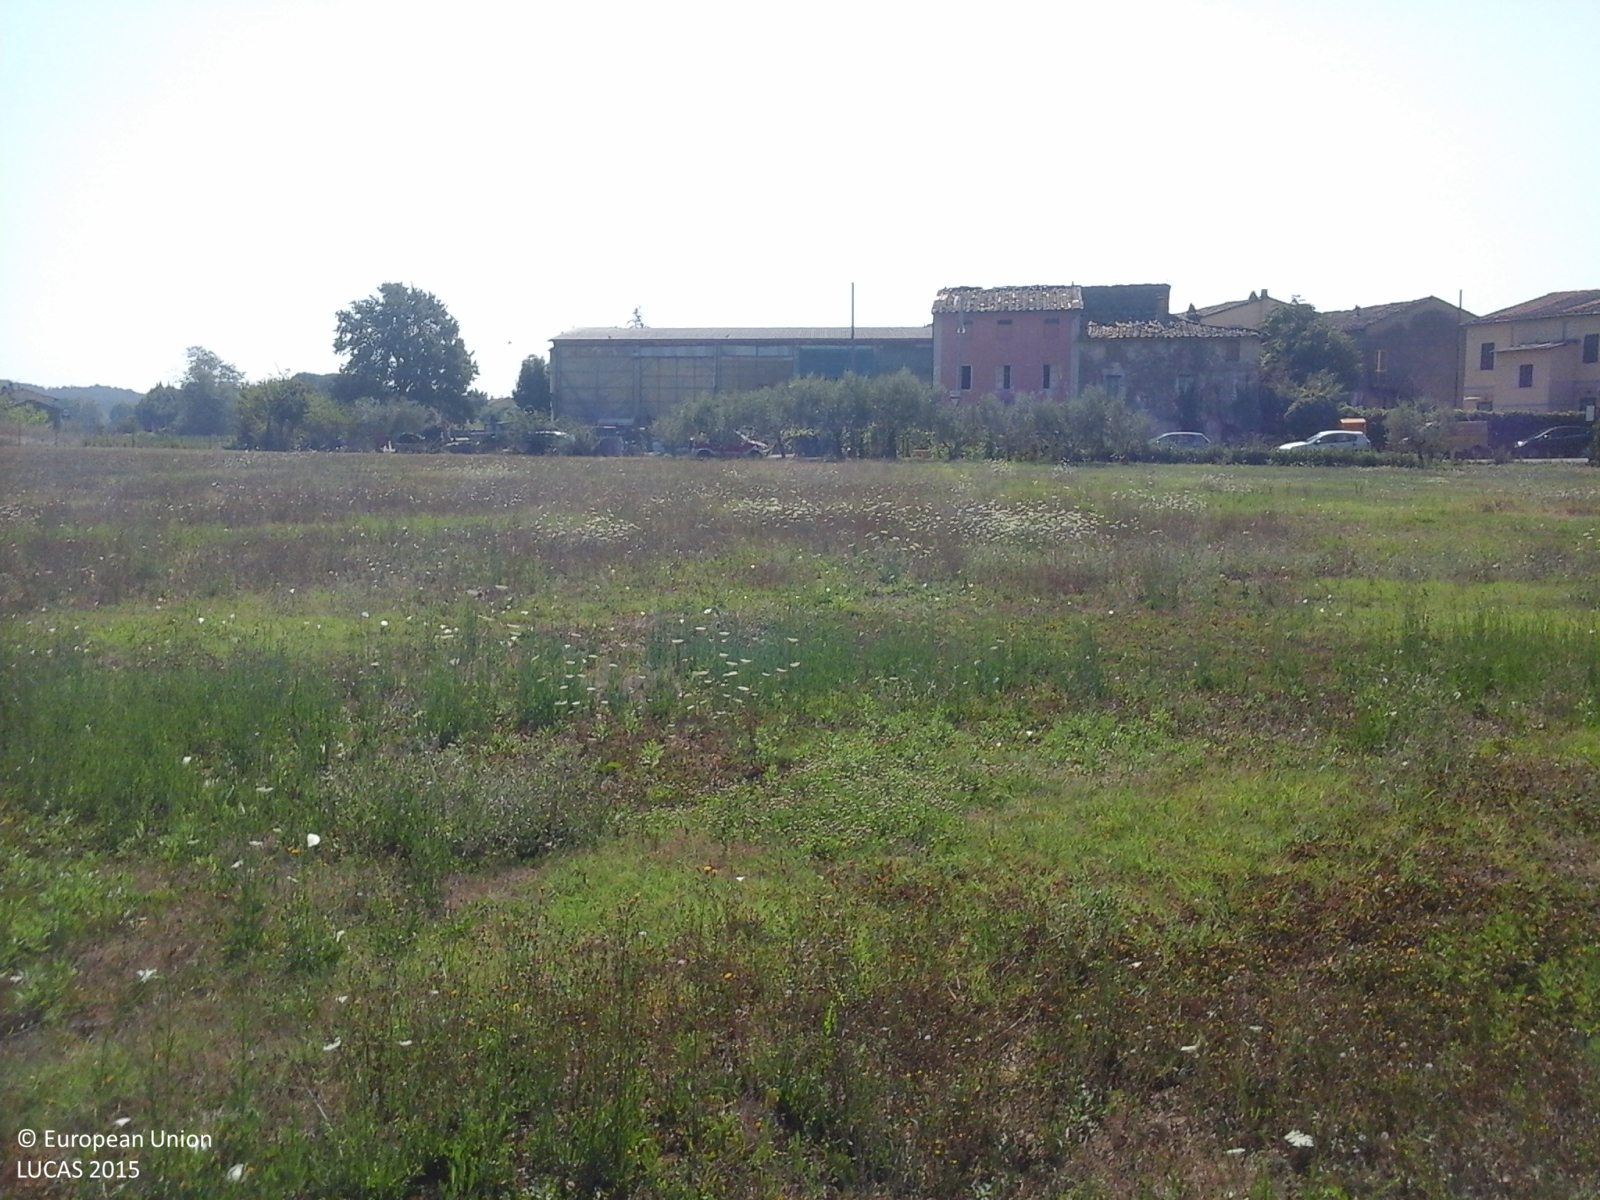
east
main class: Grassland
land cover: Spontaneously vegetated surfaces
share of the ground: > 75 %
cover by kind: herbaceous plants 100 %
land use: Agriculture (excluding fallow land and kitchen gardens)
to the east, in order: Spontaneously vegetated surfaces; Fences; Grass margins; Paved roads, cycling and walking lanes; Grass margins; Olive groves; Ditches and canals; Maize; Ditches and canals; Maize; Ditches and canals; Maize; Ditches and canals; Other fresh vegetables; Grassland without tree/shrub cover
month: August
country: IT
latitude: 43.8617
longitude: 10.6081
